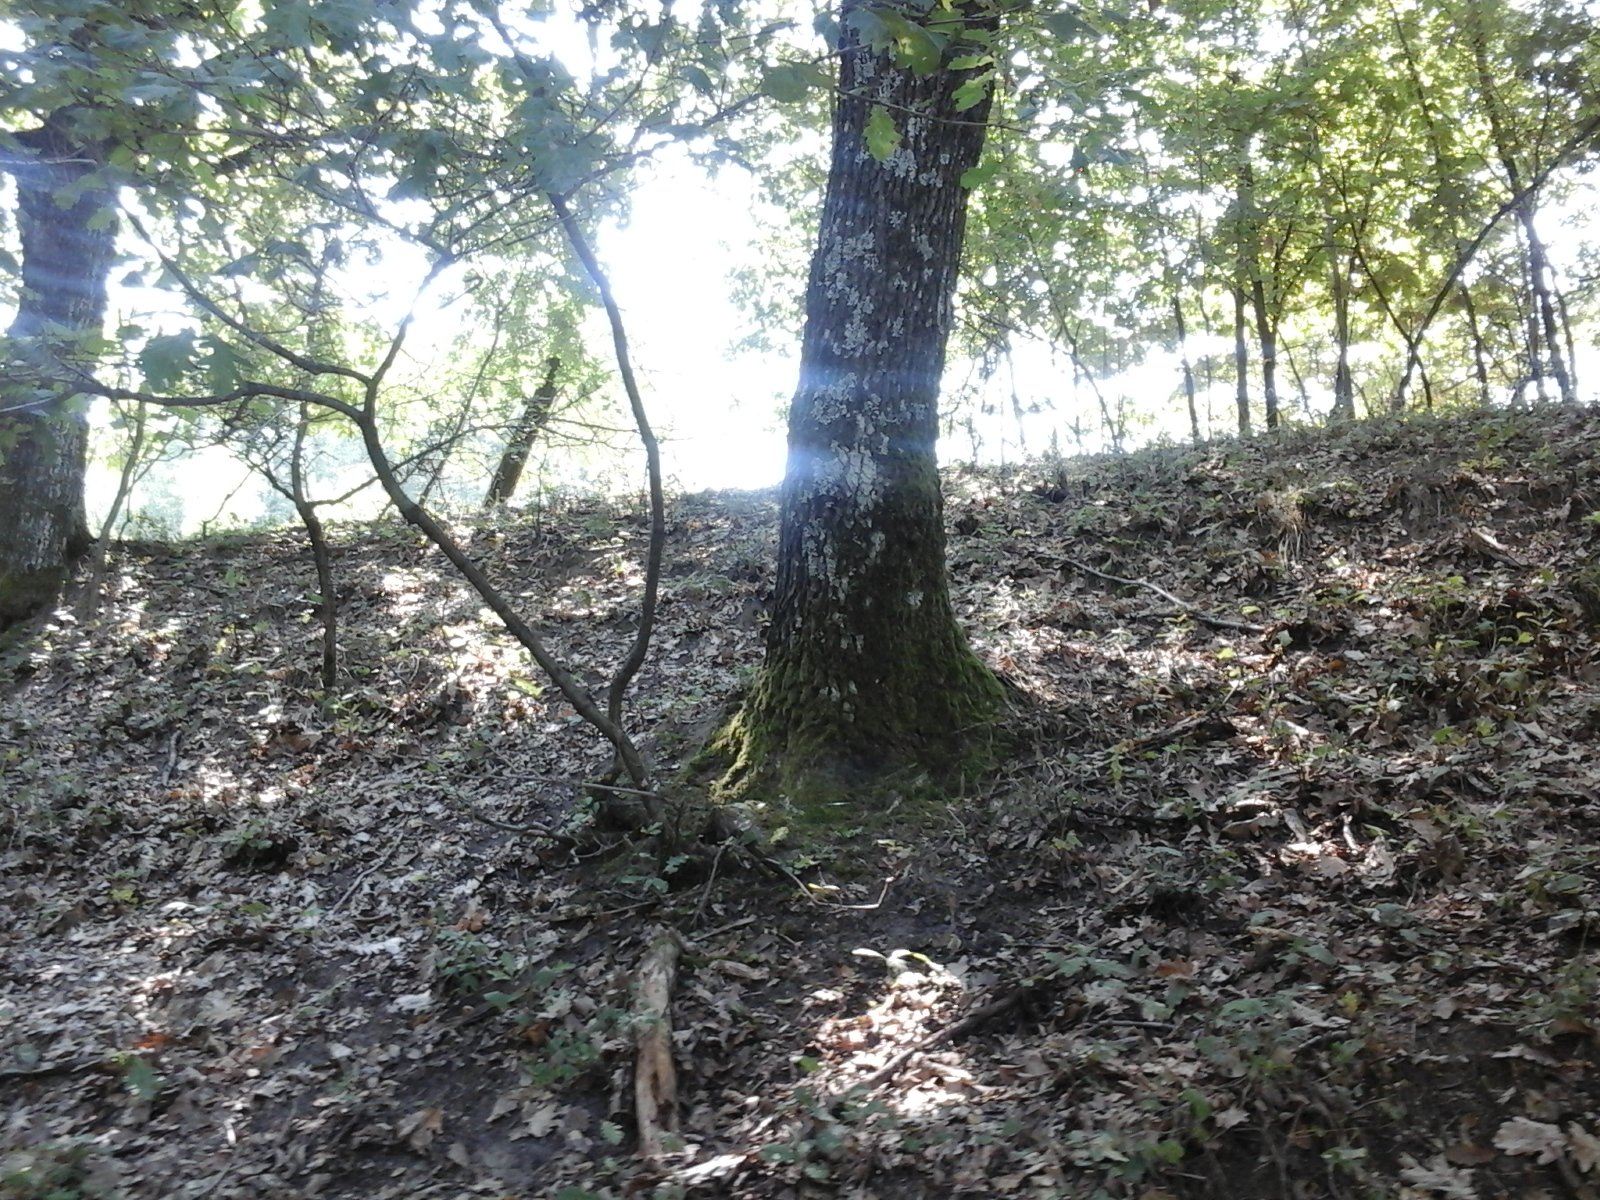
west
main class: Woodland
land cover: Broadleaved woodland
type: acidophilous oak and oak-birch forest
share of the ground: > 75 %
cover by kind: broadleaved forest trees 100 %
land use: Forestry
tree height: > 5 m
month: August
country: RO
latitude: 44.8755
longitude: 23.8731
